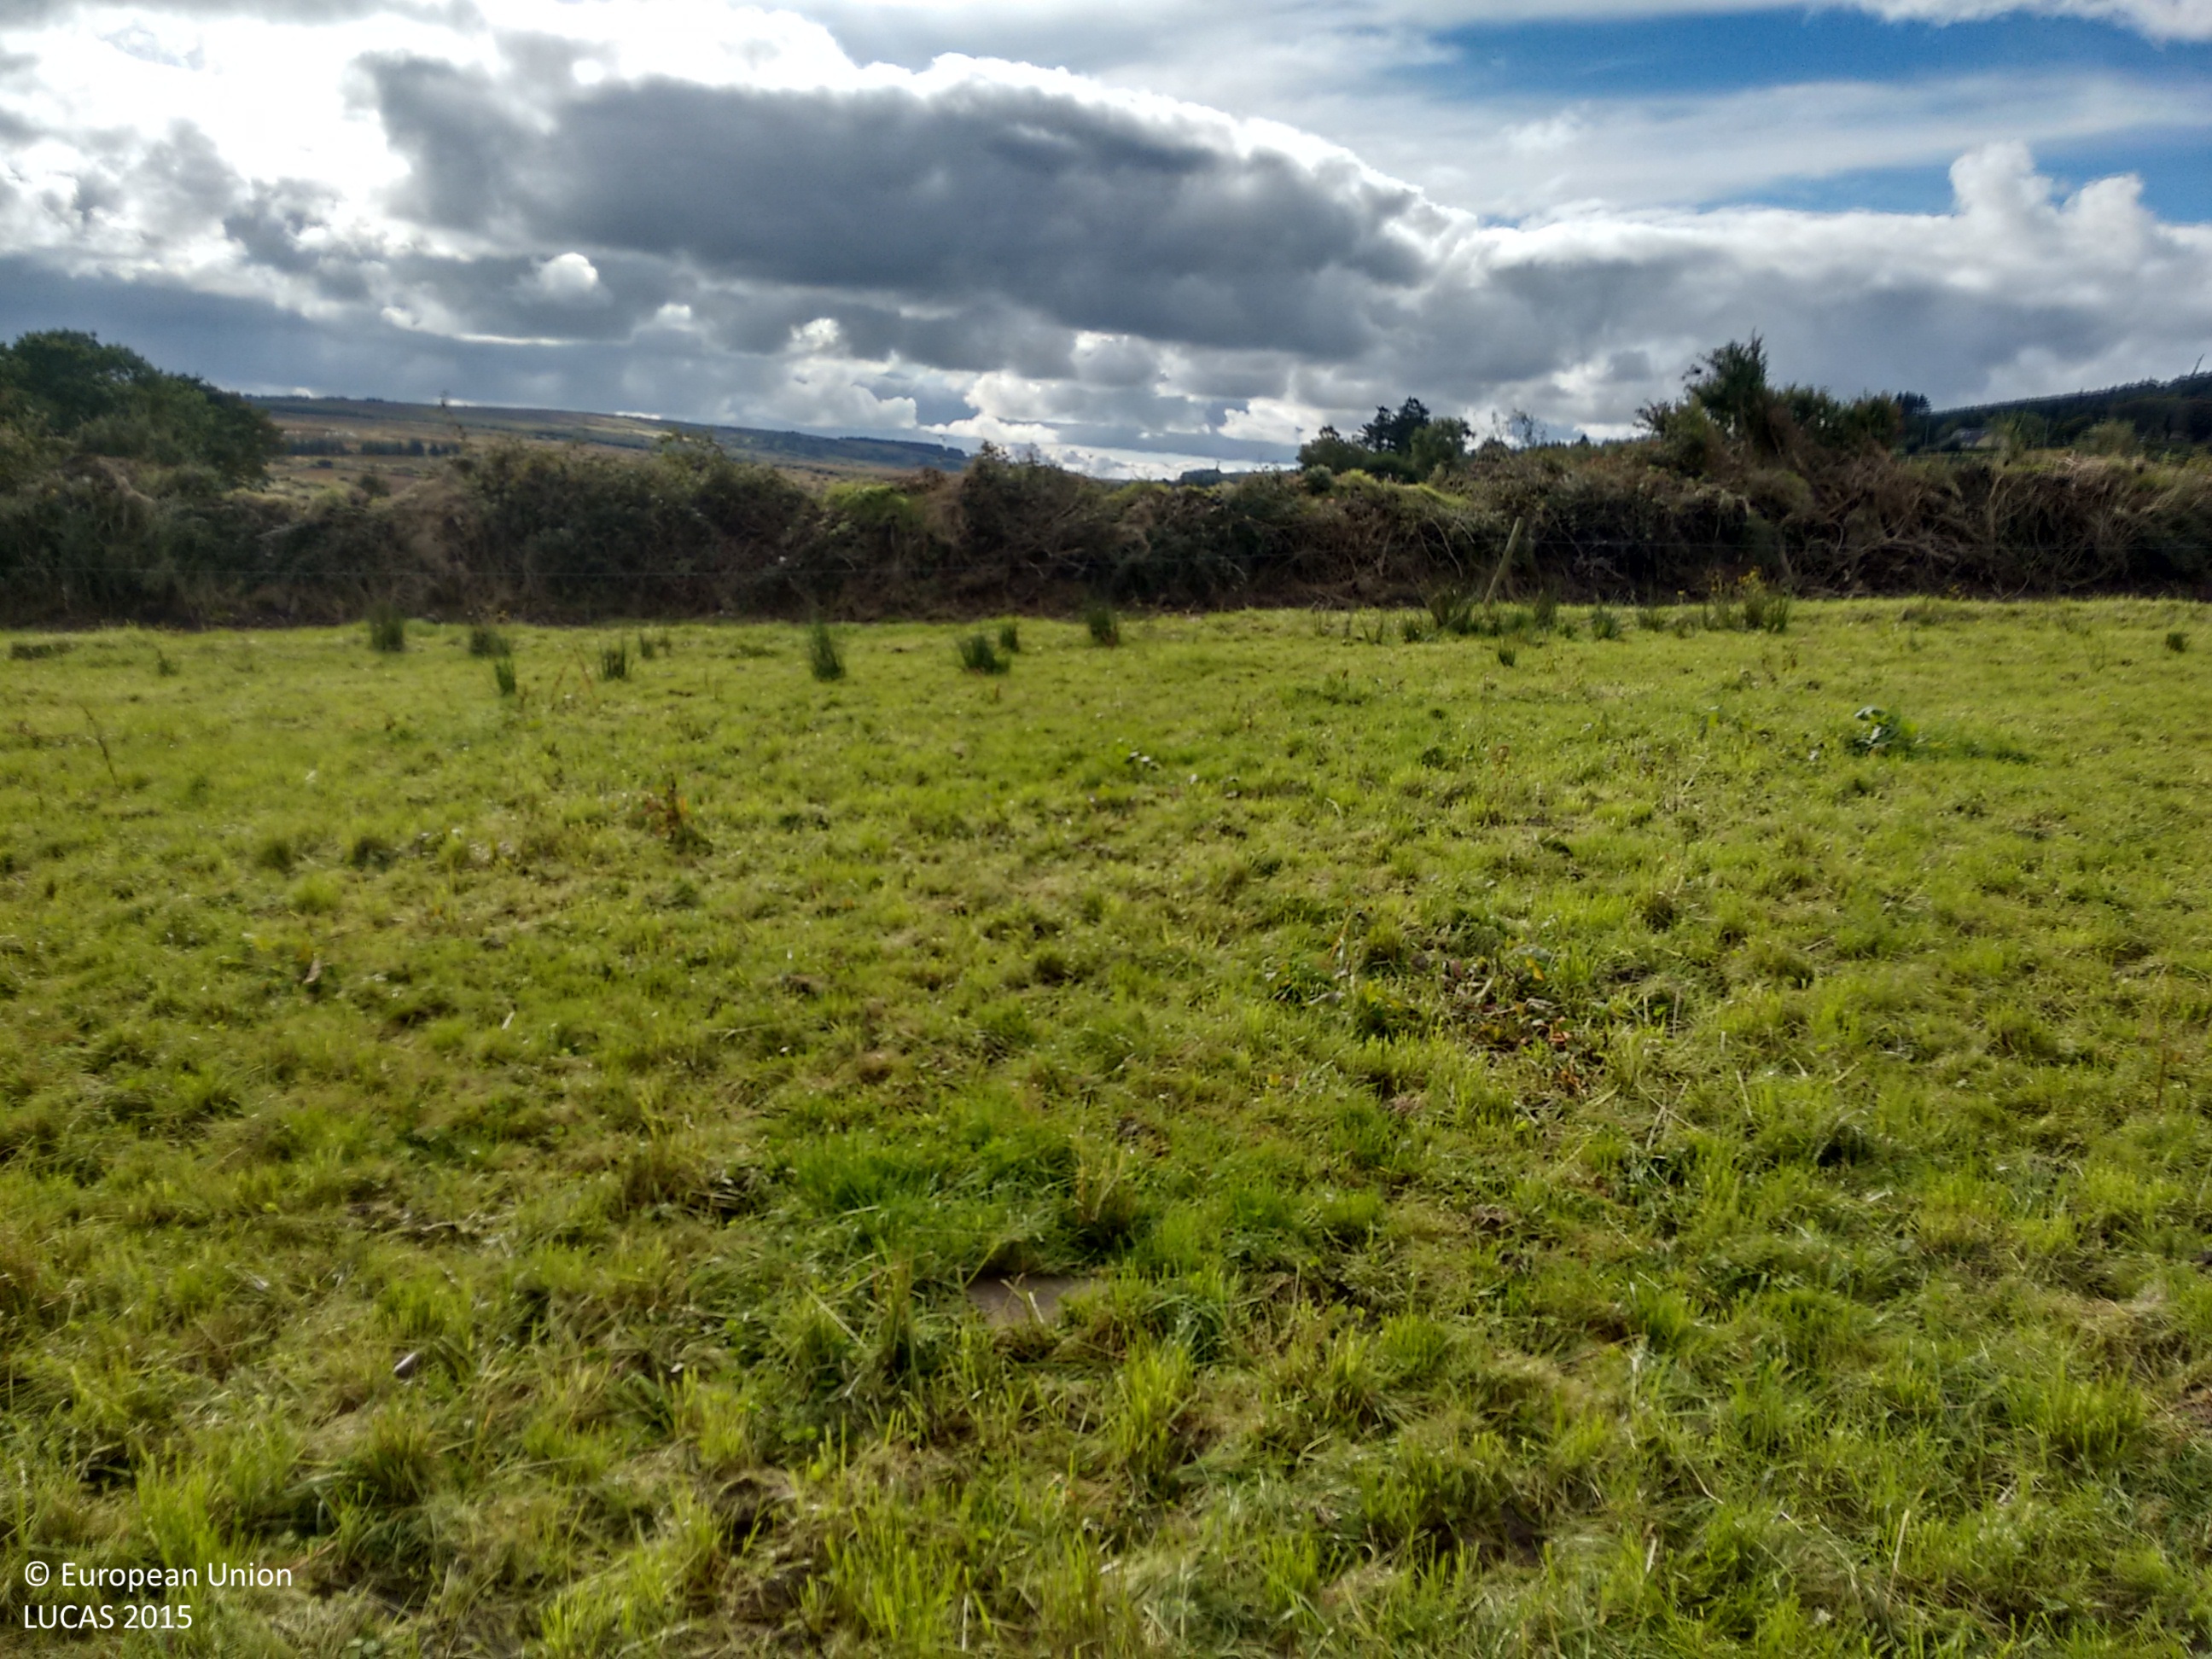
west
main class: Grassland
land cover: Grassland without tree/shrub cover
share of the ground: > 75 %
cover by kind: herbaceous plants 85 %, unconsolidated bare surface 10 %, shrubs 5 %
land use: Agriculture (excluding fallow land and kitchen gardens)
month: September
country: IE
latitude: 52.3272
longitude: -9.4072
